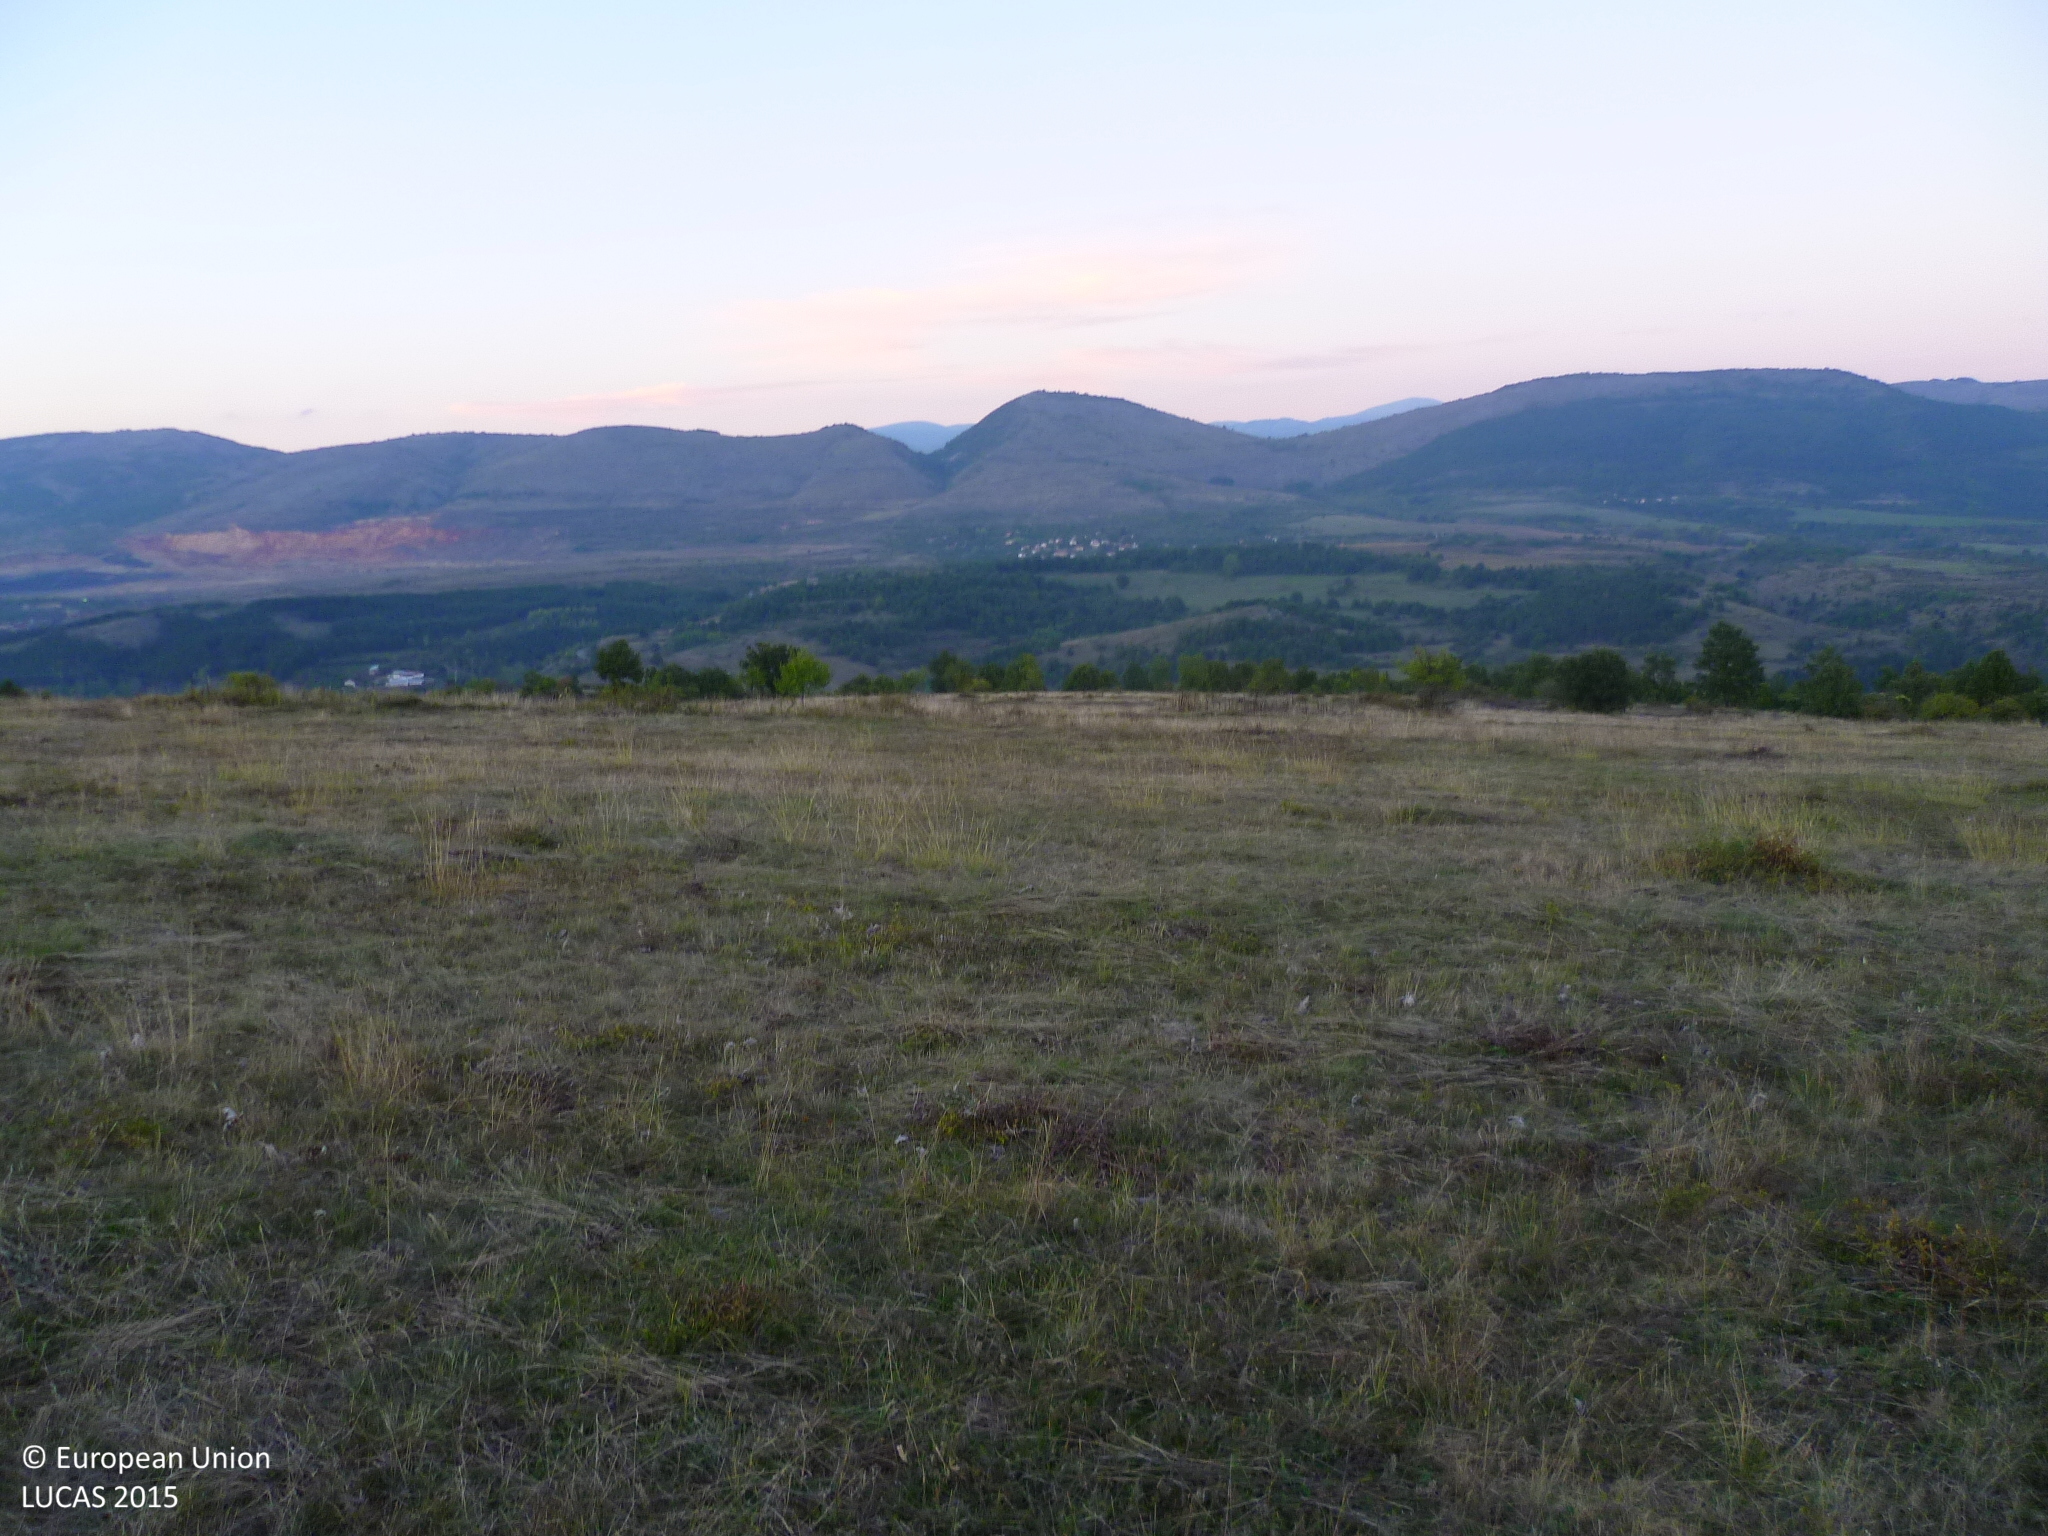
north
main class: Grassland
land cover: Grassland without tree/shrub cover
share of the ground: > 75 %
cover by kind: herbaceous plants 100 %
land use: Agriculture (excluding fallow land and kitchen gardens)
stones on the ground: > 50 %
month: October
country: BG
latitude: 43.0267
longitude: 22.9298
